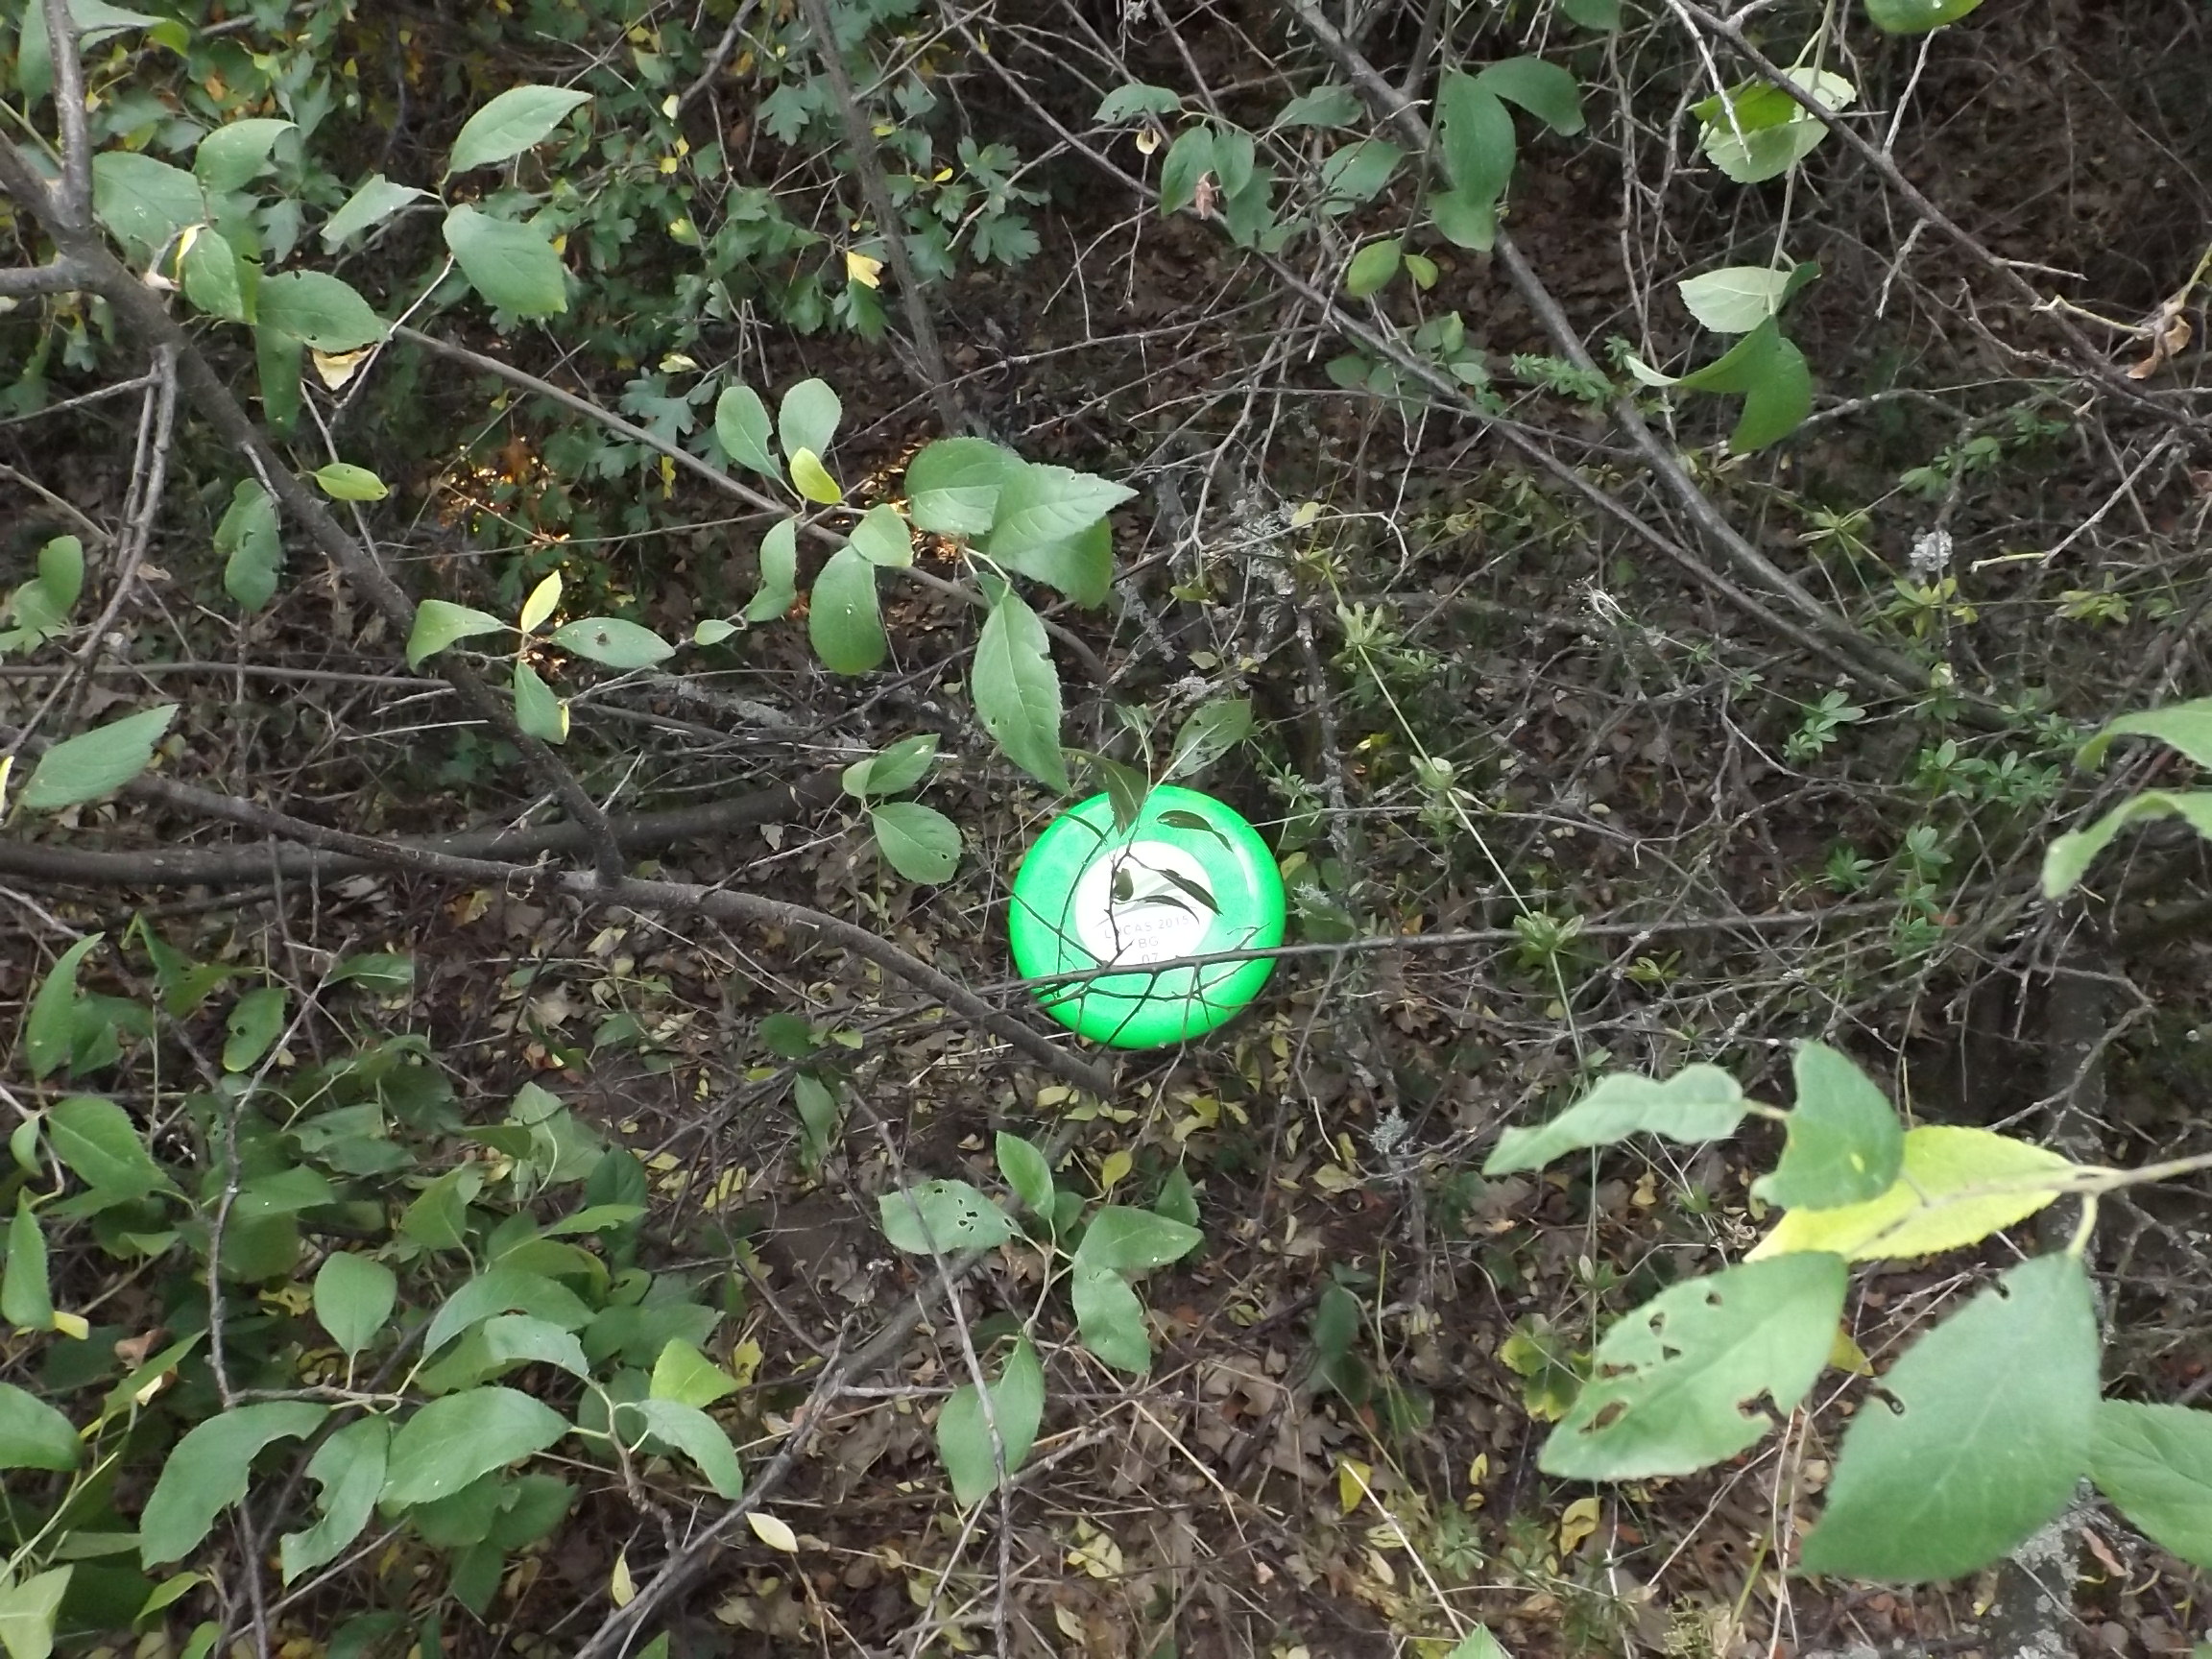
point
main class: Woodland
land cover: Broadleaved woodland
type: beech forest
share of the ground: 50 - 75 %
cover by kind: broadleaved forest trees 70 %, shrubs 20 %, herbaceous plants 10 %
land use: Forestry
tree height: > 5 m
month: July
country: BG
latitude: 43.4721
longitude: 27.6262
